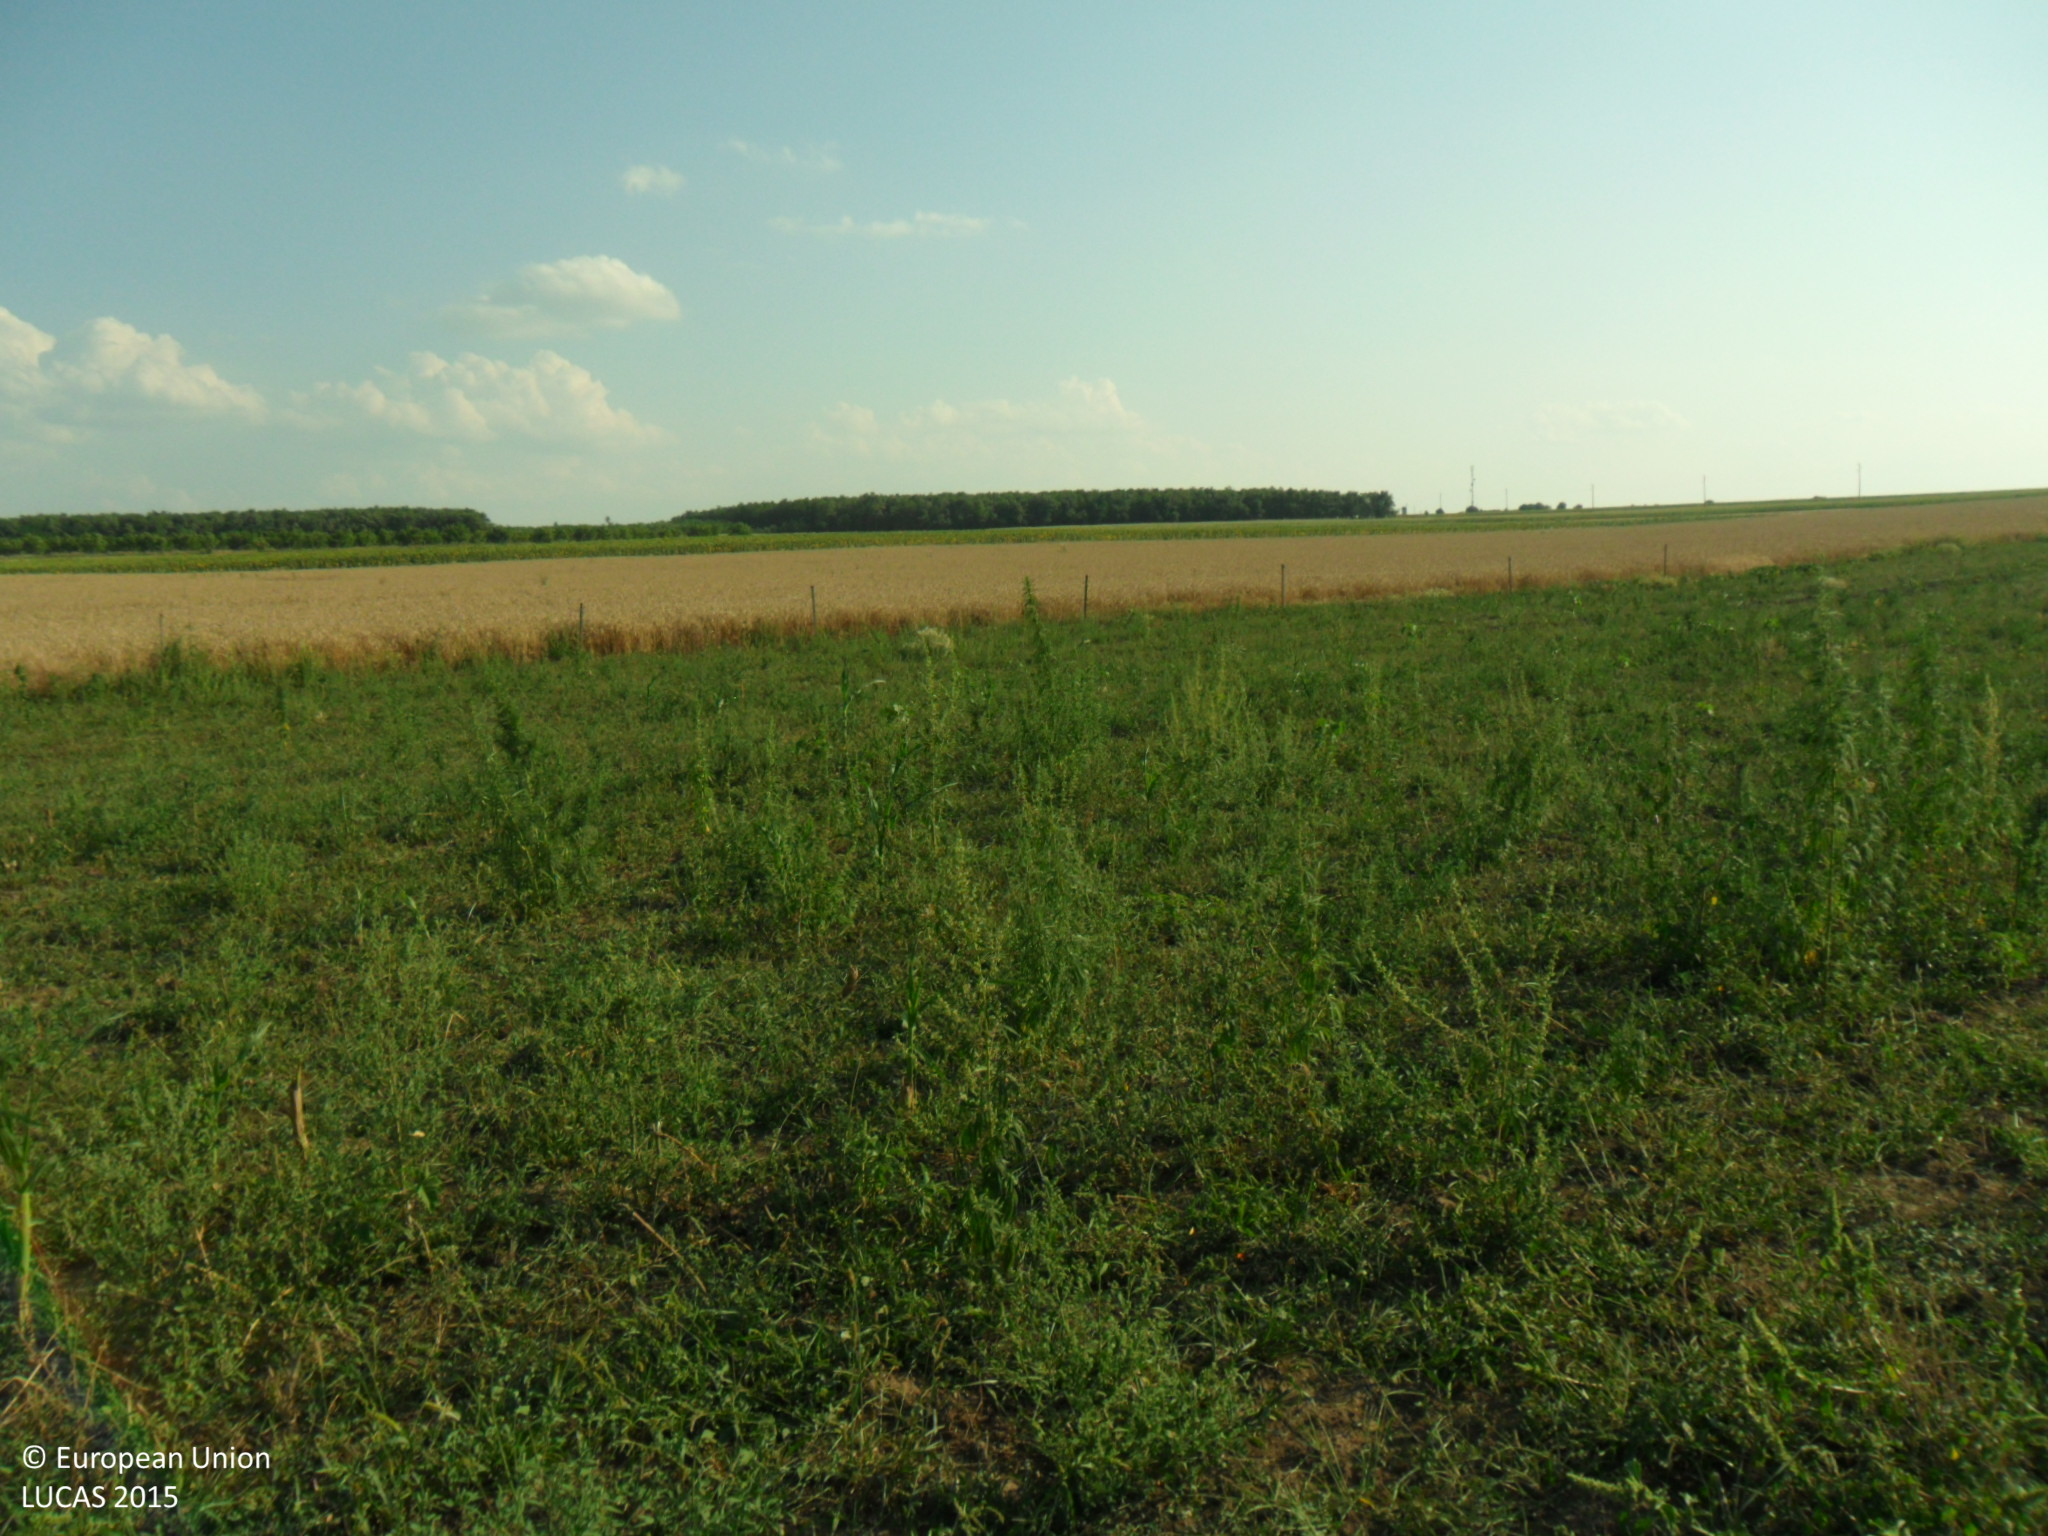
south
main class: Cropland
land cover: Maize
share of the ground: 10 - 25 %
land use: Agriculture (excluding fallow land and kitchen gardens)
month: July
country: BG
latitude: 43.6942
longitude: 27.0828
